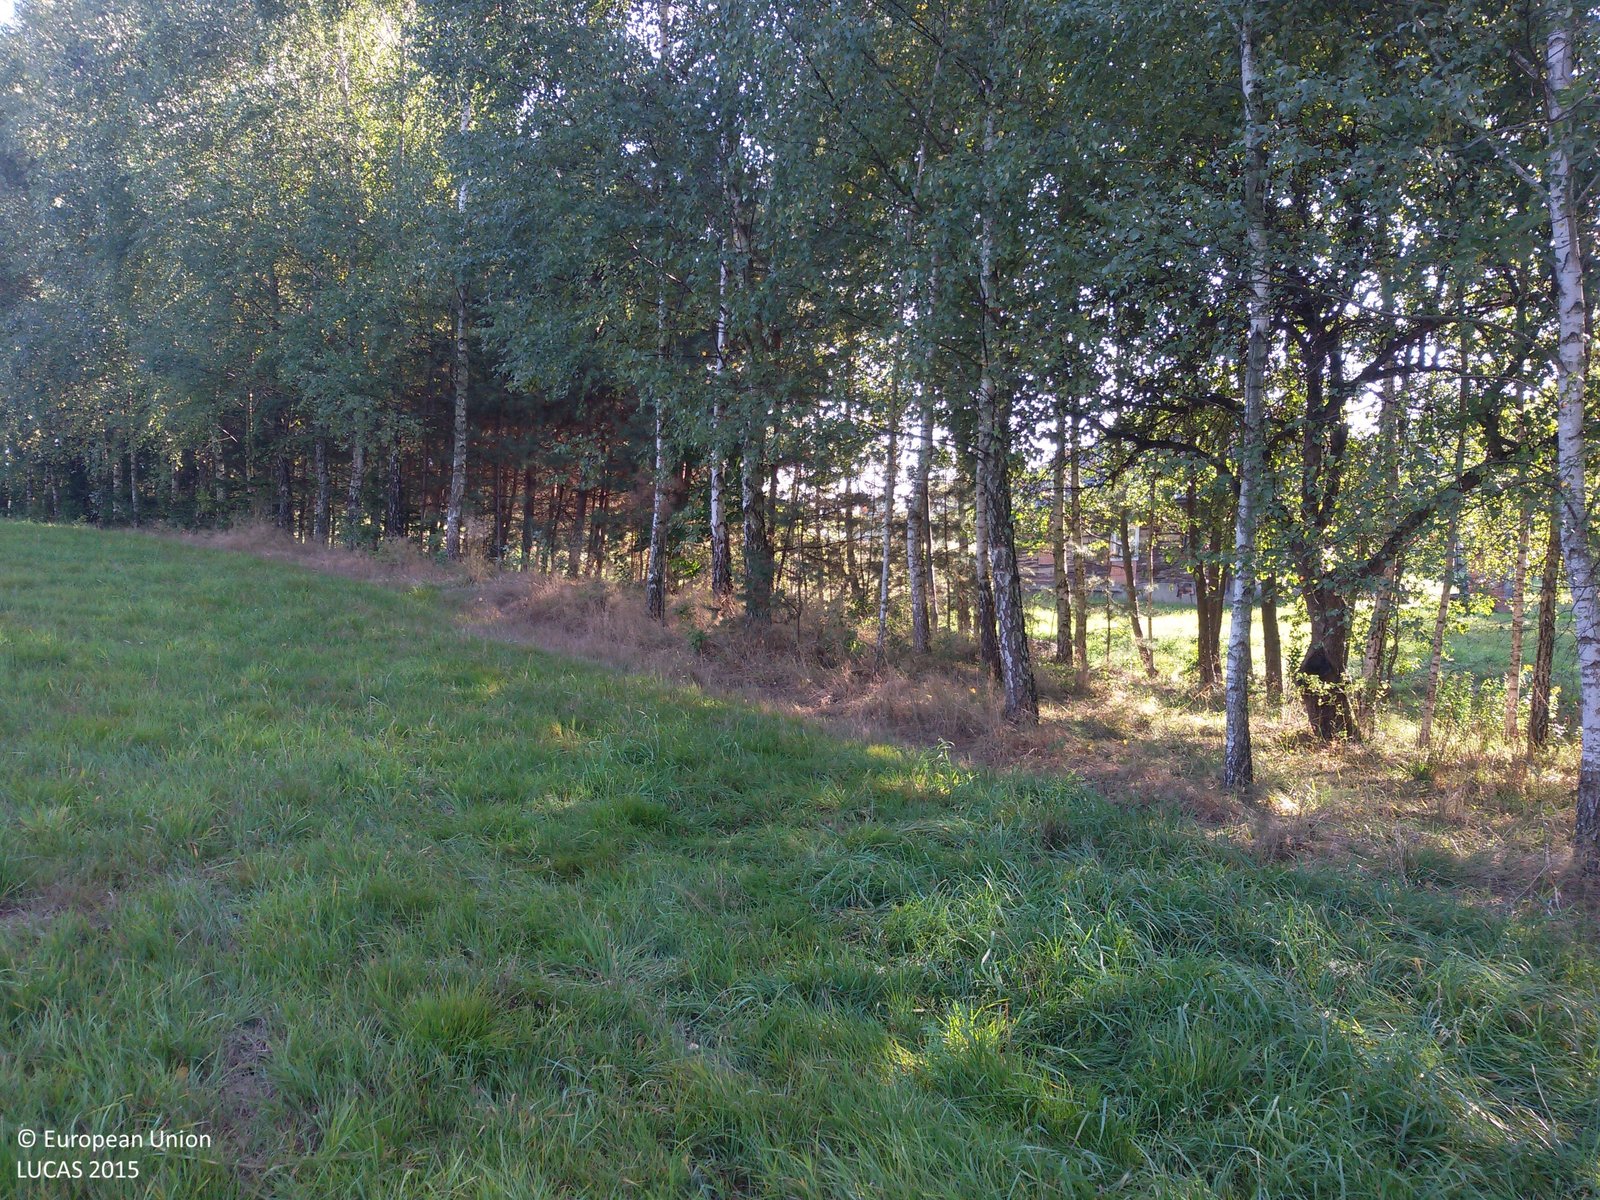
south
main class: Grassland
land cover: Grassland without tree/shrub cover
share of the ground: > 75 %
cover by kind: herbaceous plants 100 %
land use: Agriculture (excluding fallow land and kitchen gardens)
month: September
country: PL
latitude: 49.6668
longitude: 21.1992
